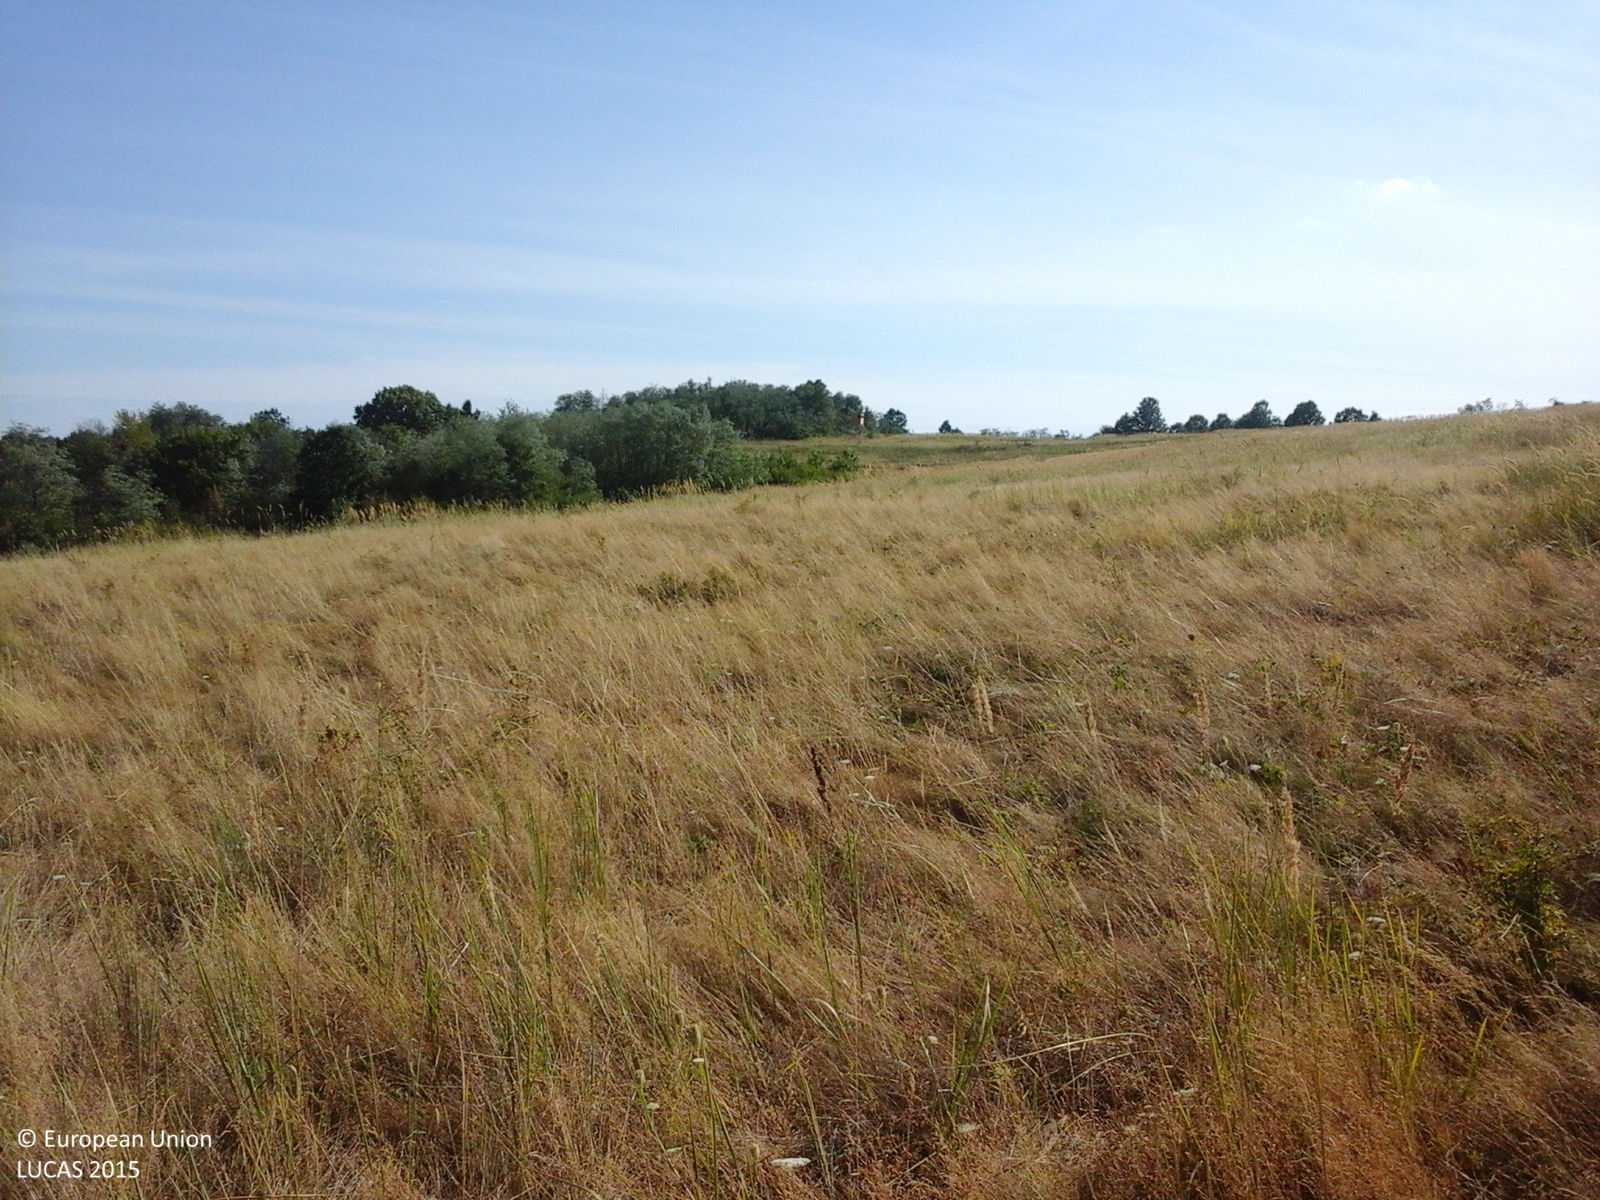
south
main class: Grassland
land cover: Grassland without tree/shrub cover
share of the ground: > 75 %
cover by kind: herbaceous plants 100 %
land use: Agriculture (excluding fallow land and kitchen gardens)
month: August
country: RO
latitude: 45.1423
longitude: 21.5398
